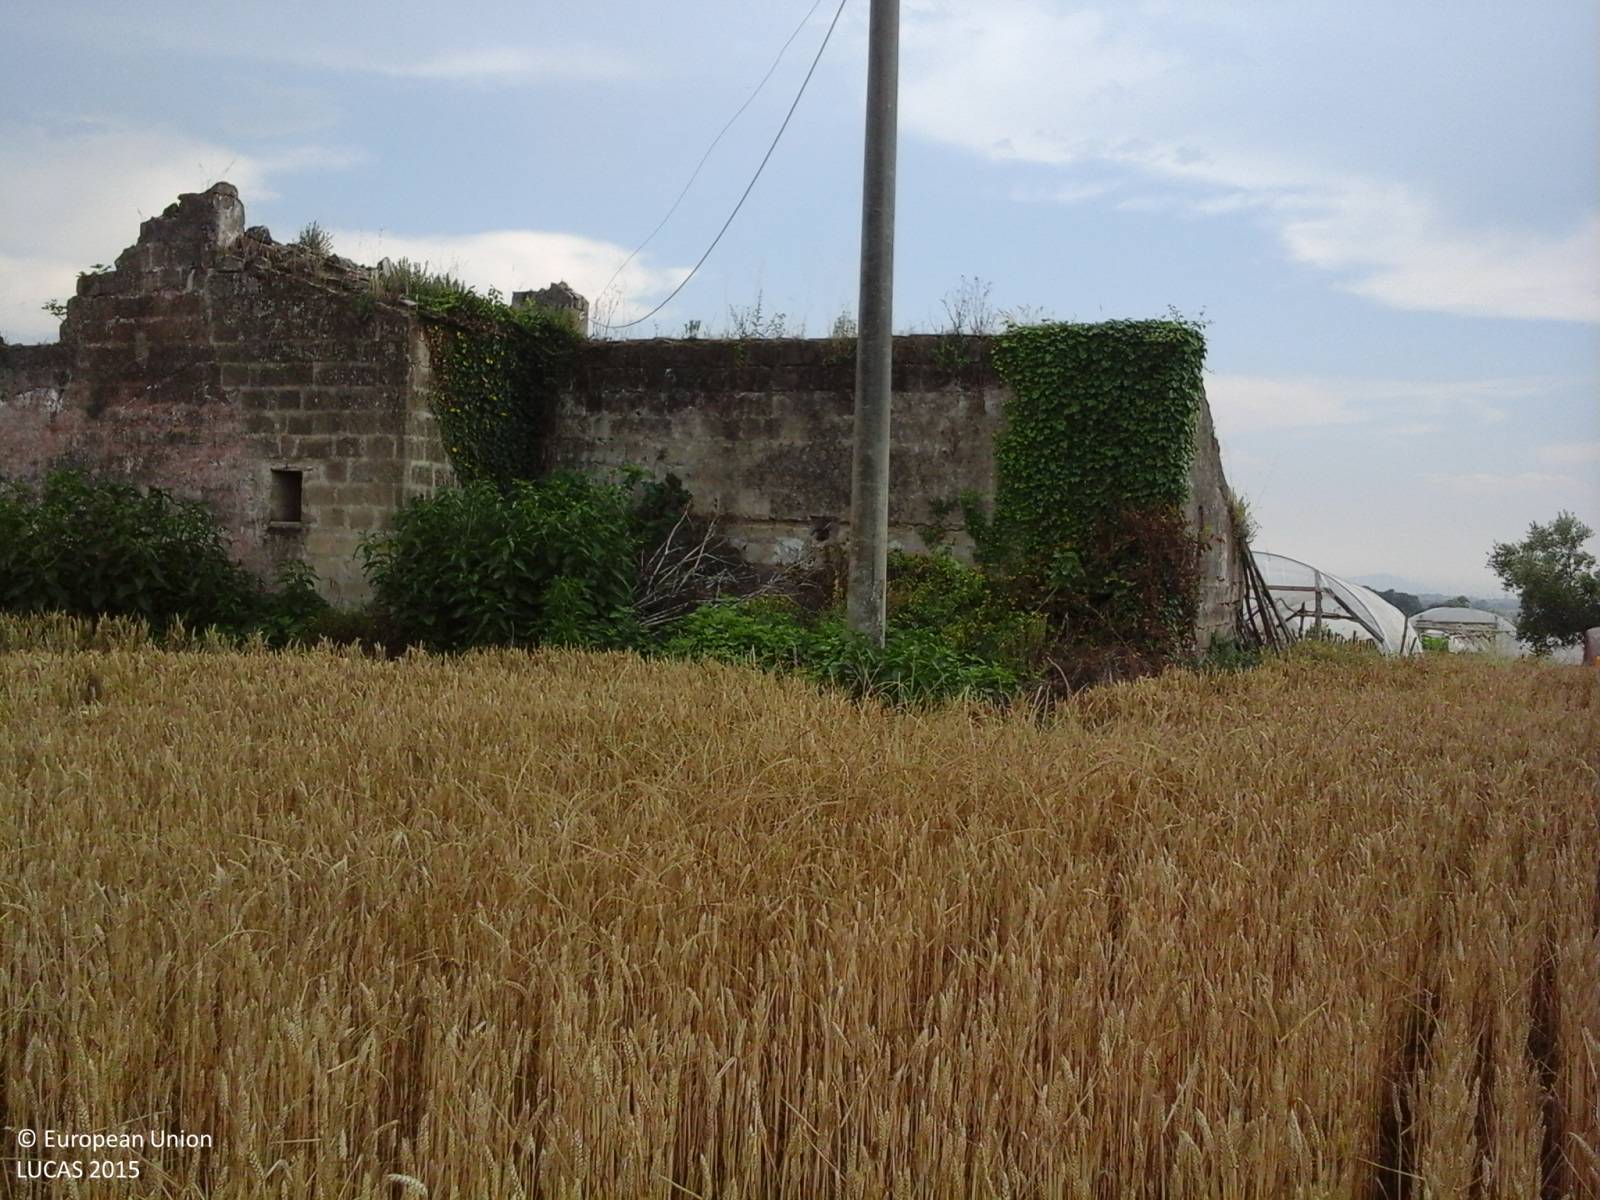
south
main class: Cropland
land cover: Common wheat
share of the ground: > 75 %
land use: Agriculture (excluding fallow land and kitchen gardens)
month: June
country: IT
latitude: 41.1580
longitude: 14.1426
